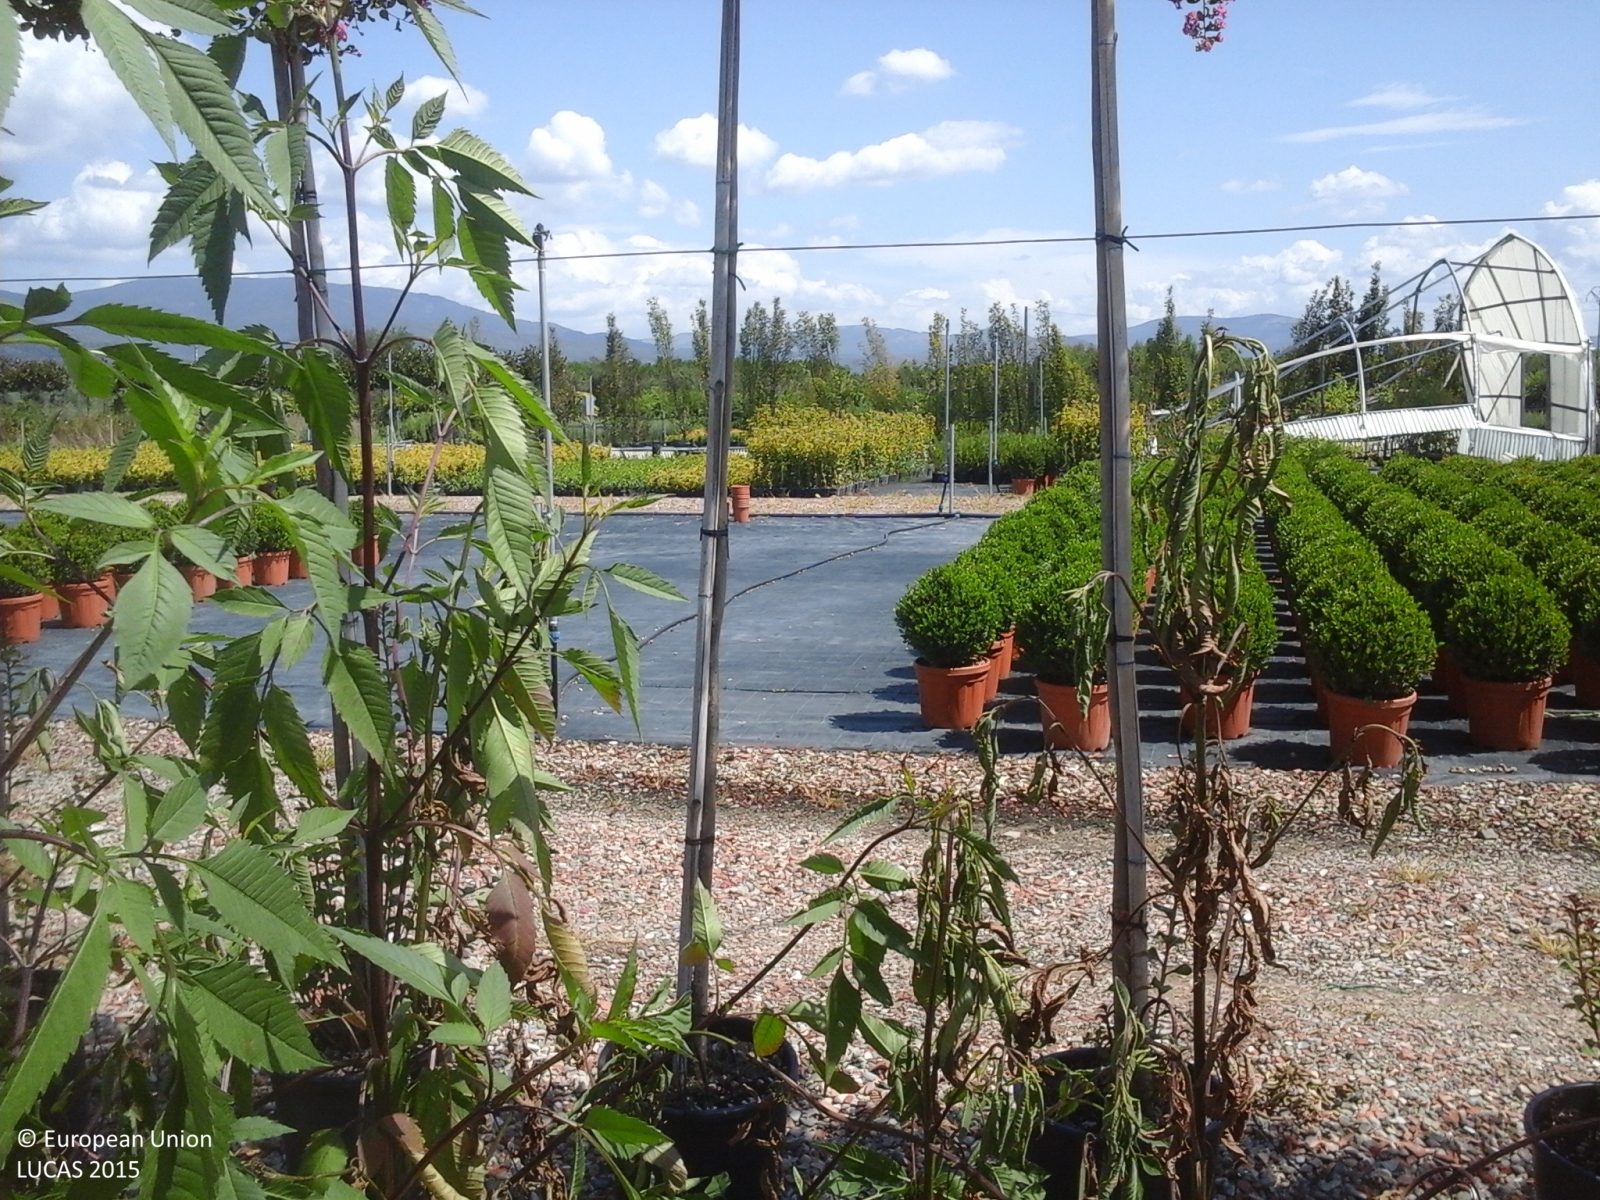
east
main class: Grassland
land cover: Spontaneously vegetated surfaces
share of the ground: > 75 %
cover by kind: herbaceous plants 95 %, shrubs 5 %
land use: Agriculture (excluding fallow land and kitchen gardens)
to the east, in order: Spontaneously vegetated surfaces; Managed hedges; Tracks; Nurseries; Electric lines; Tracks; Nurseries; Tracks; Nurseries; Tracks; Nurseries; Tracks; Nurseries; Tracks; Nurseries; Tracks; Ditches and canals; Pine dominated coniferous woodland; Ditches and canals; Nurseries; Spontaneously vegetated surfaces
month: August
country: IT
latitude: 43.9132
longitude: 10.9564
